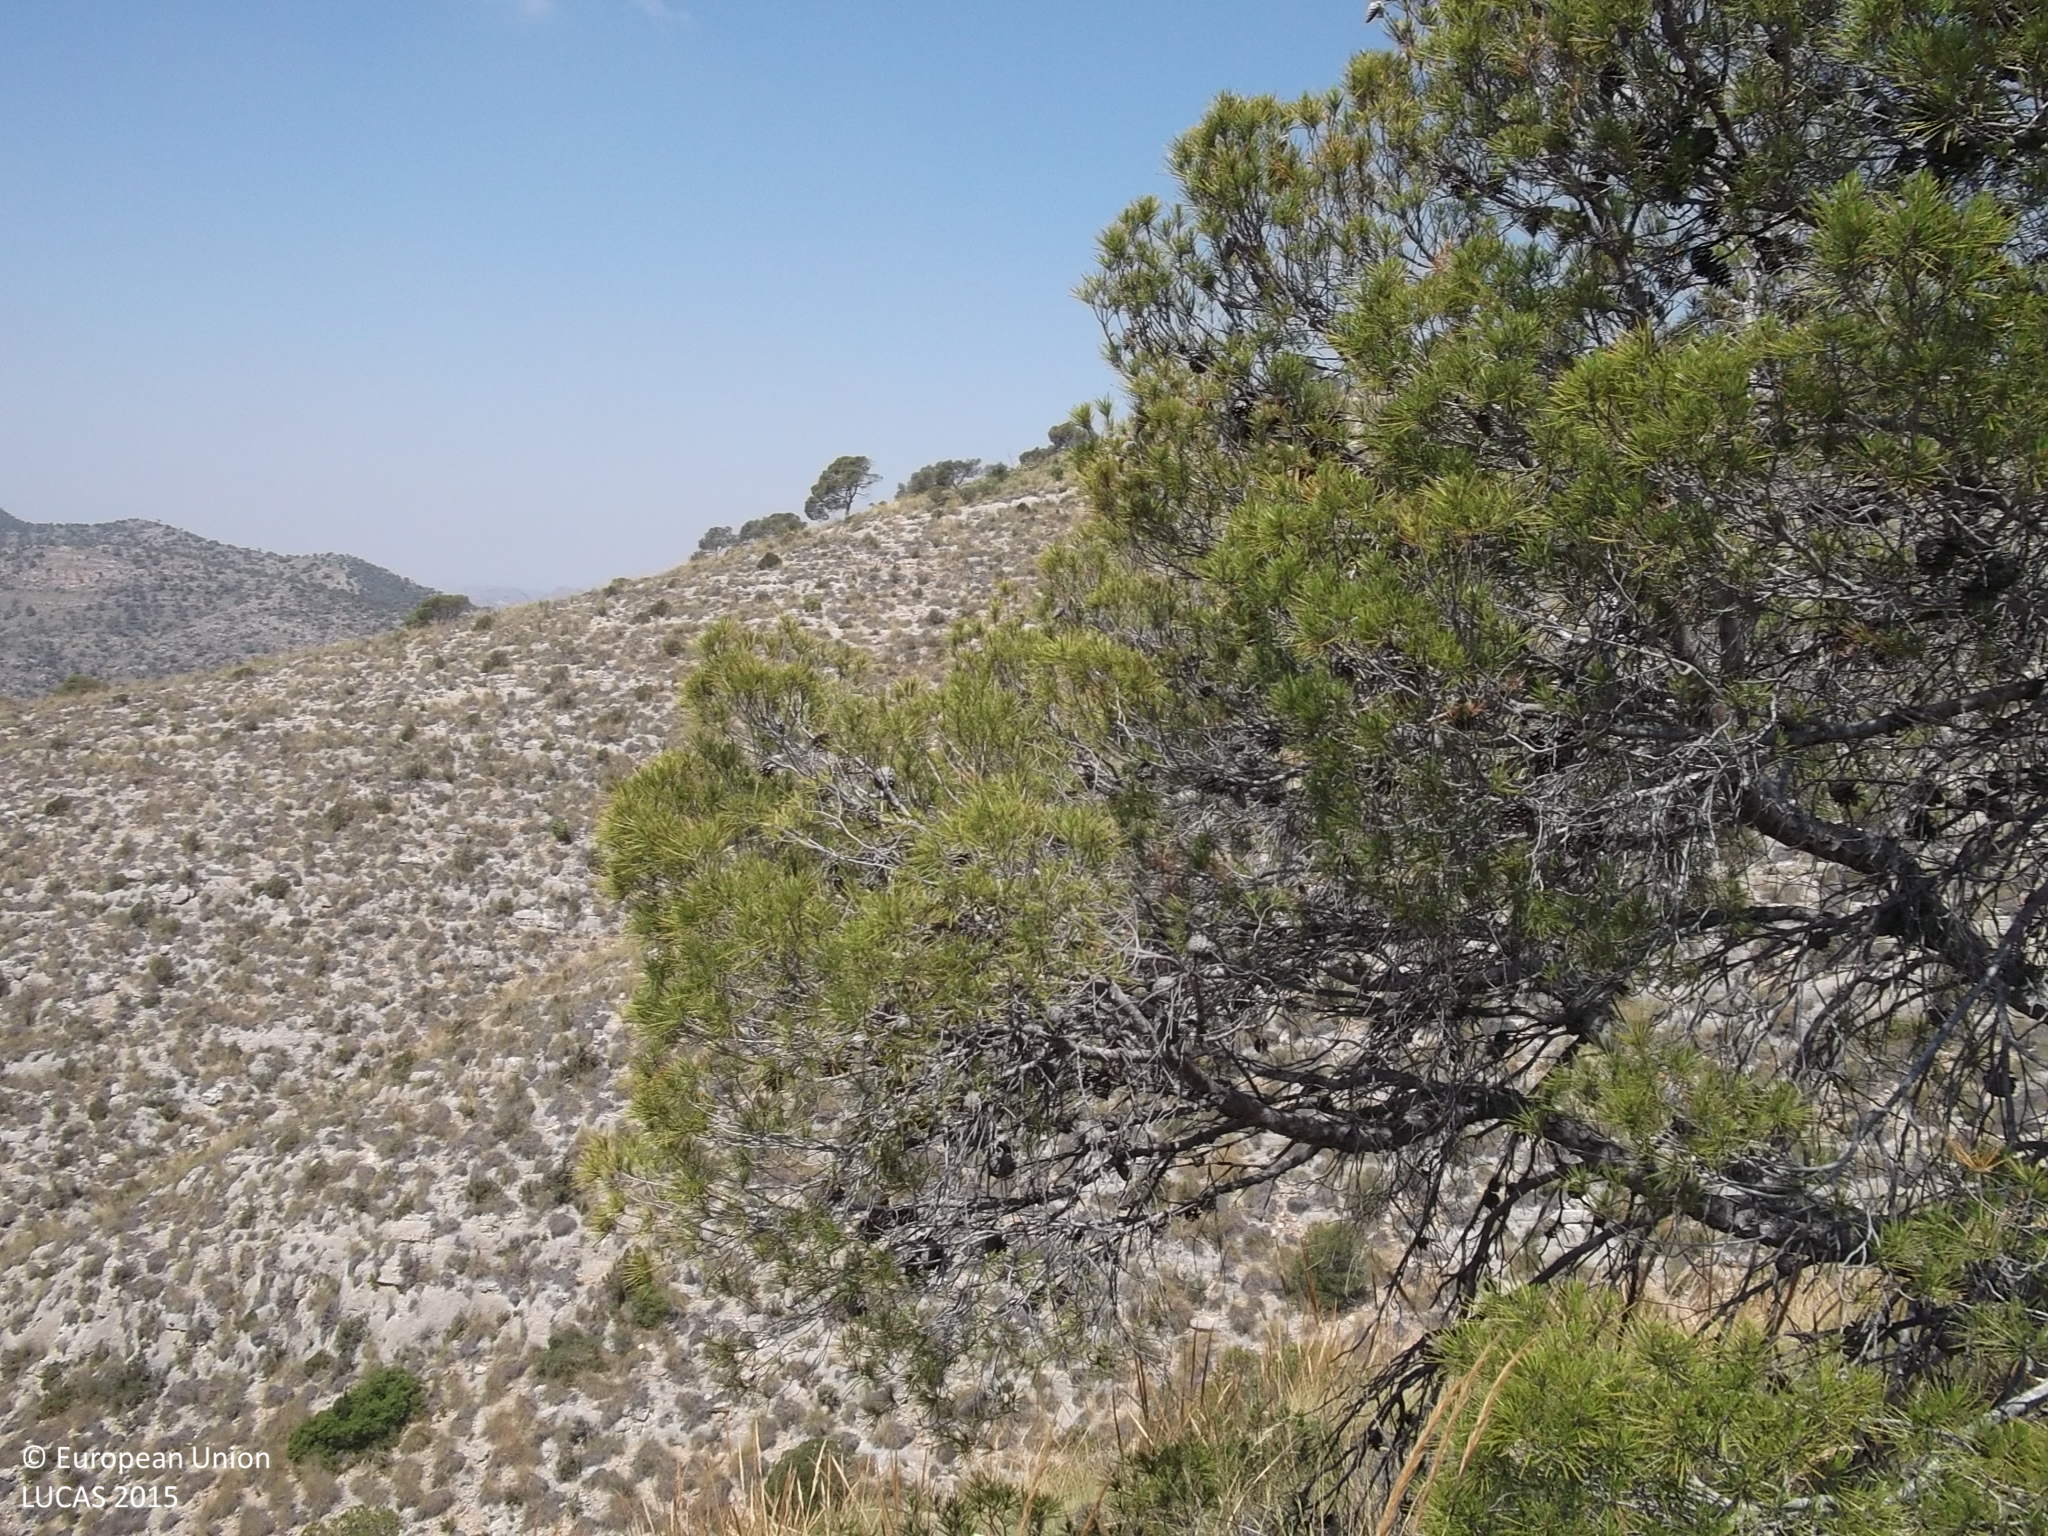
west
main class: Woodland
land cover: Pine dominated coniferous woodland
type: coniferous forest of the mediterranean region
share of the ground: 10 - 25 %
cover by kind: shrubs 30 %, consolidated bare surface 30 %, coniferous forest trees 20 %, herbaceous plants 20 %
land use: Semi-natural and natural areas not in use
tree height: > 5 m
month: May
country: ES
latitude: 38.4452
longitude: -1.4372
